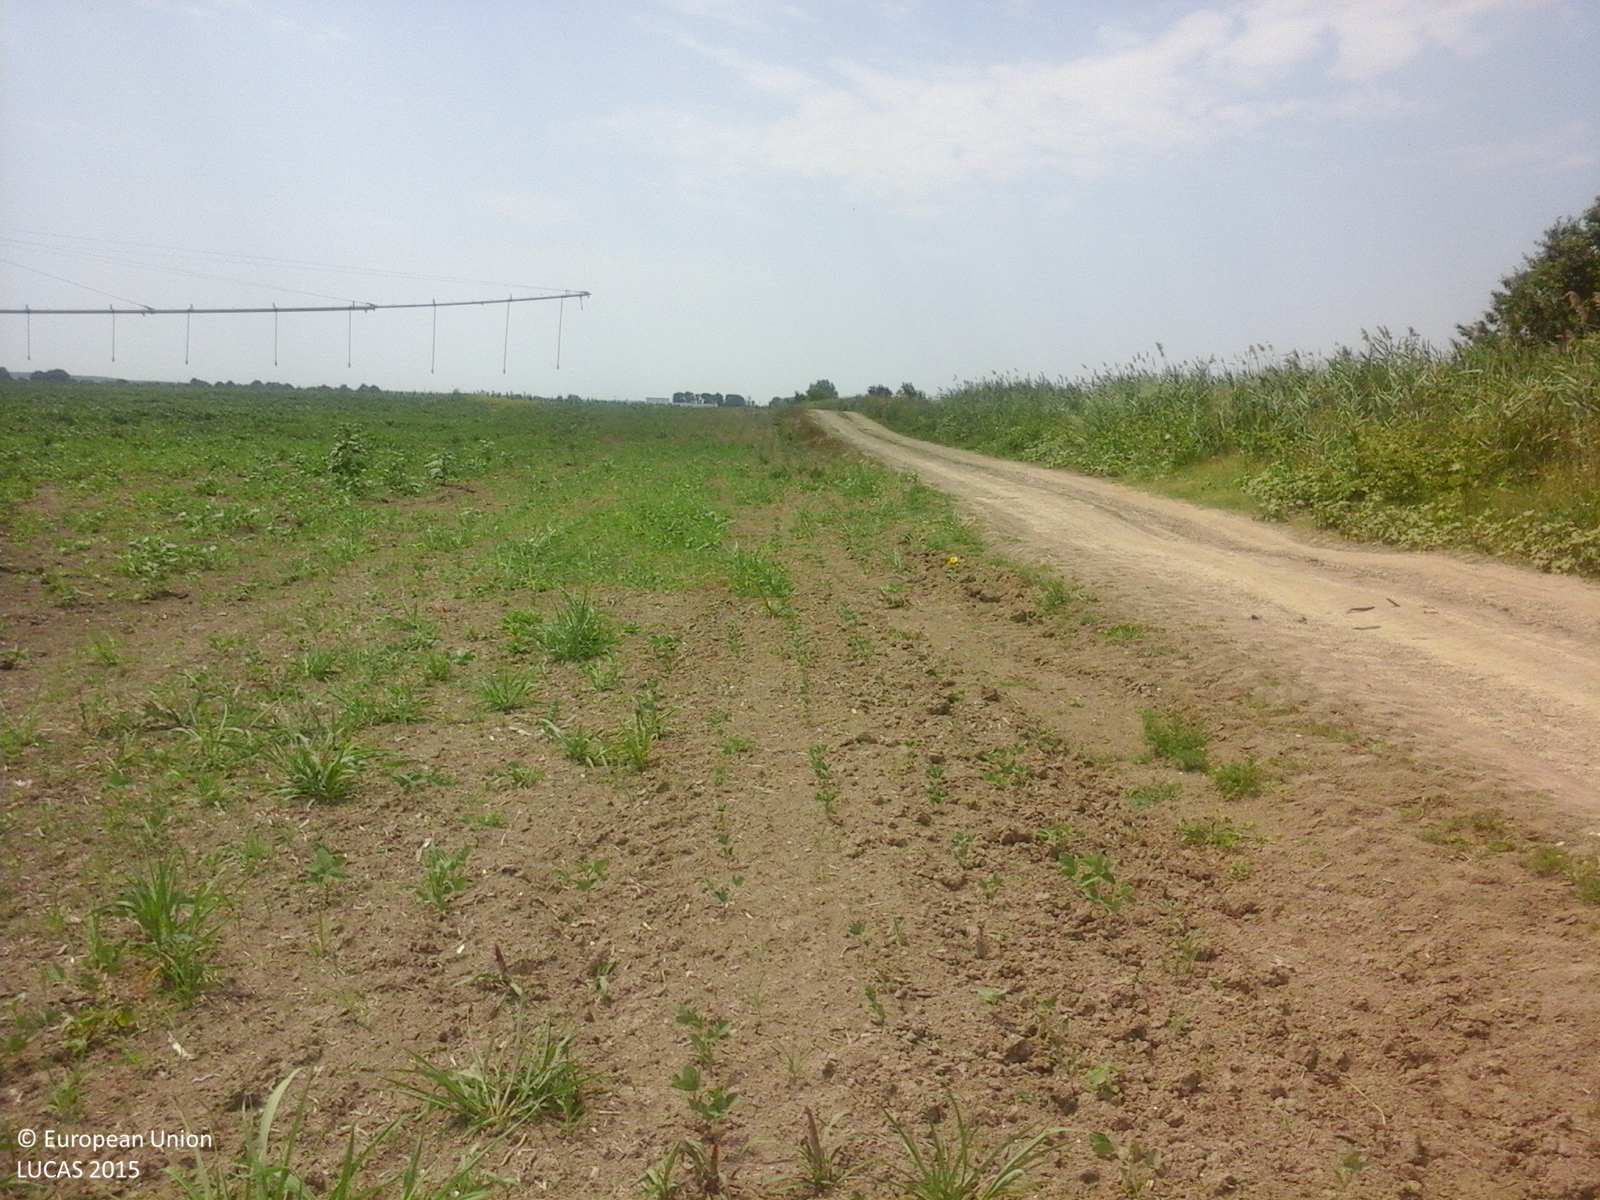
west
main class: Cropland
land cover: Soya
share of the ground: 10 - 25 %
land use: Agriculture (excluding fallow land and kitchen gardens)
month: July
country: RO
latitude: 44.5504
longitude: 27.9953
